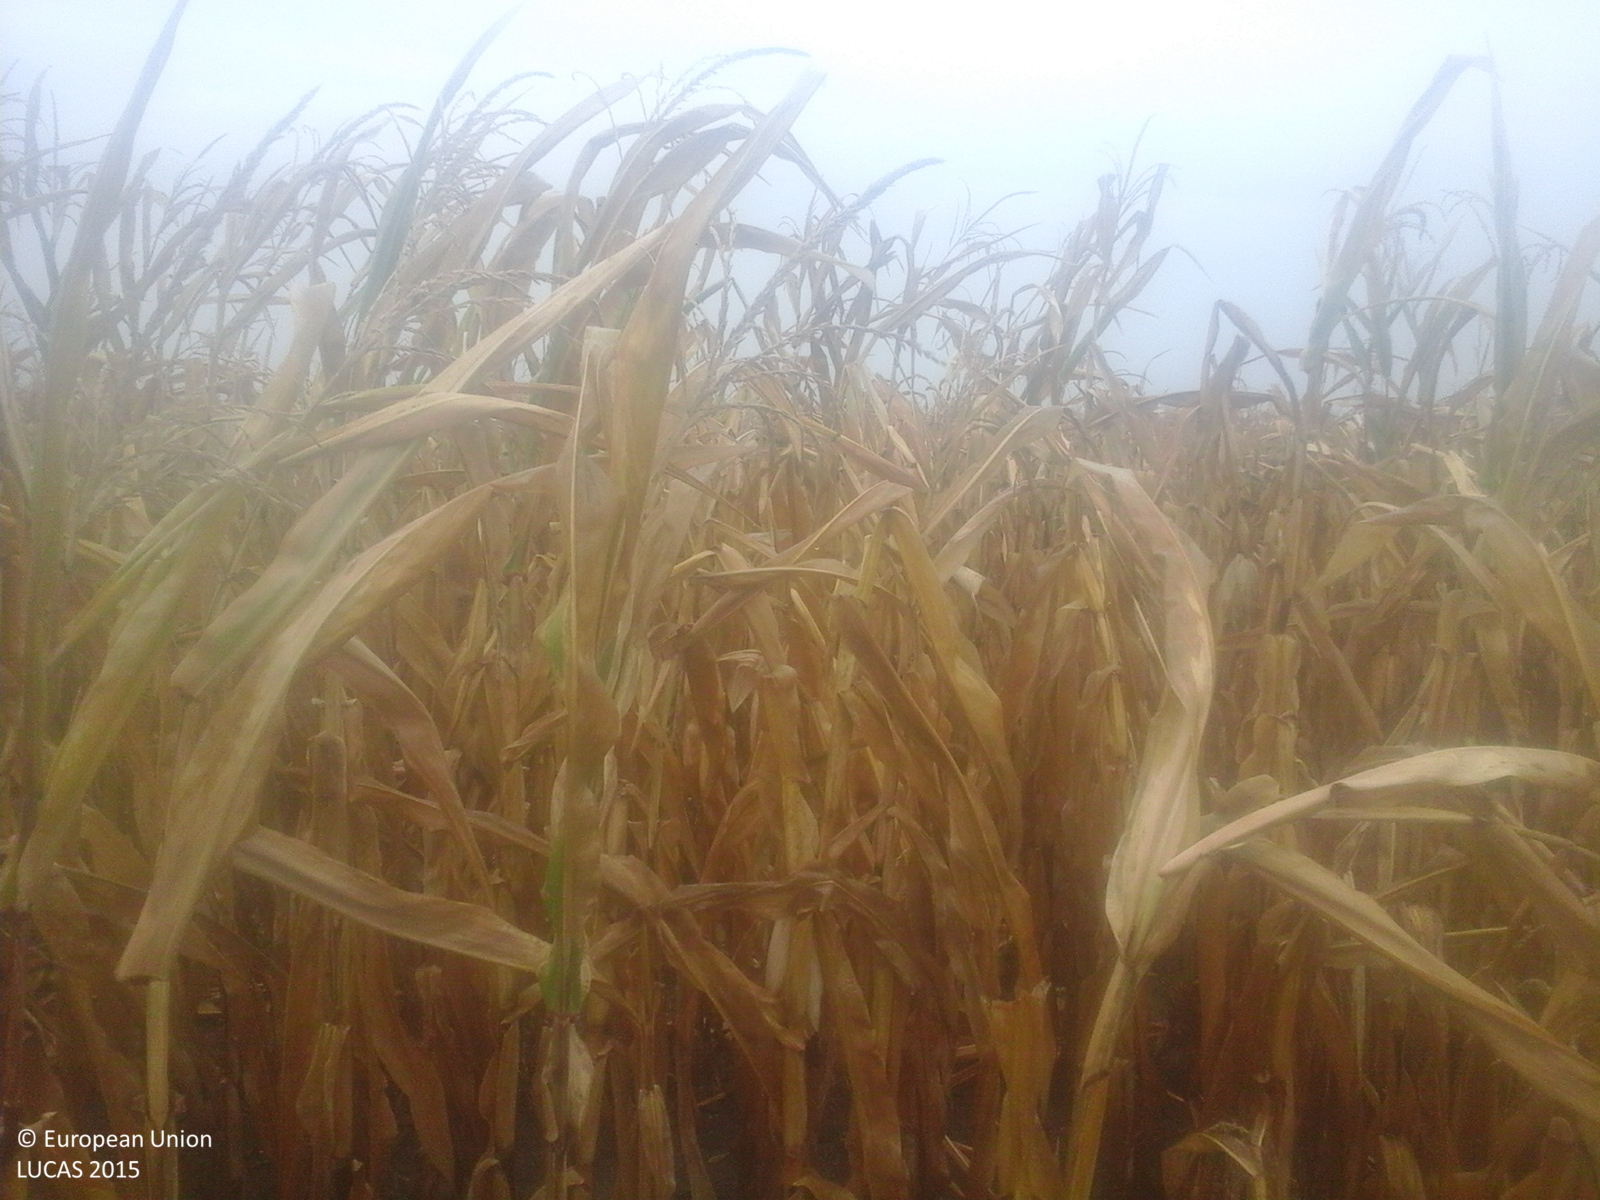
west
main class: Cropland
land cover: Maize
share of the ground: > 75 %
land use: Agriculture (excluding fallow land and kitchen gardens)
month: September
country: RO
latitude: 47.5150
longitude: 22.4455
